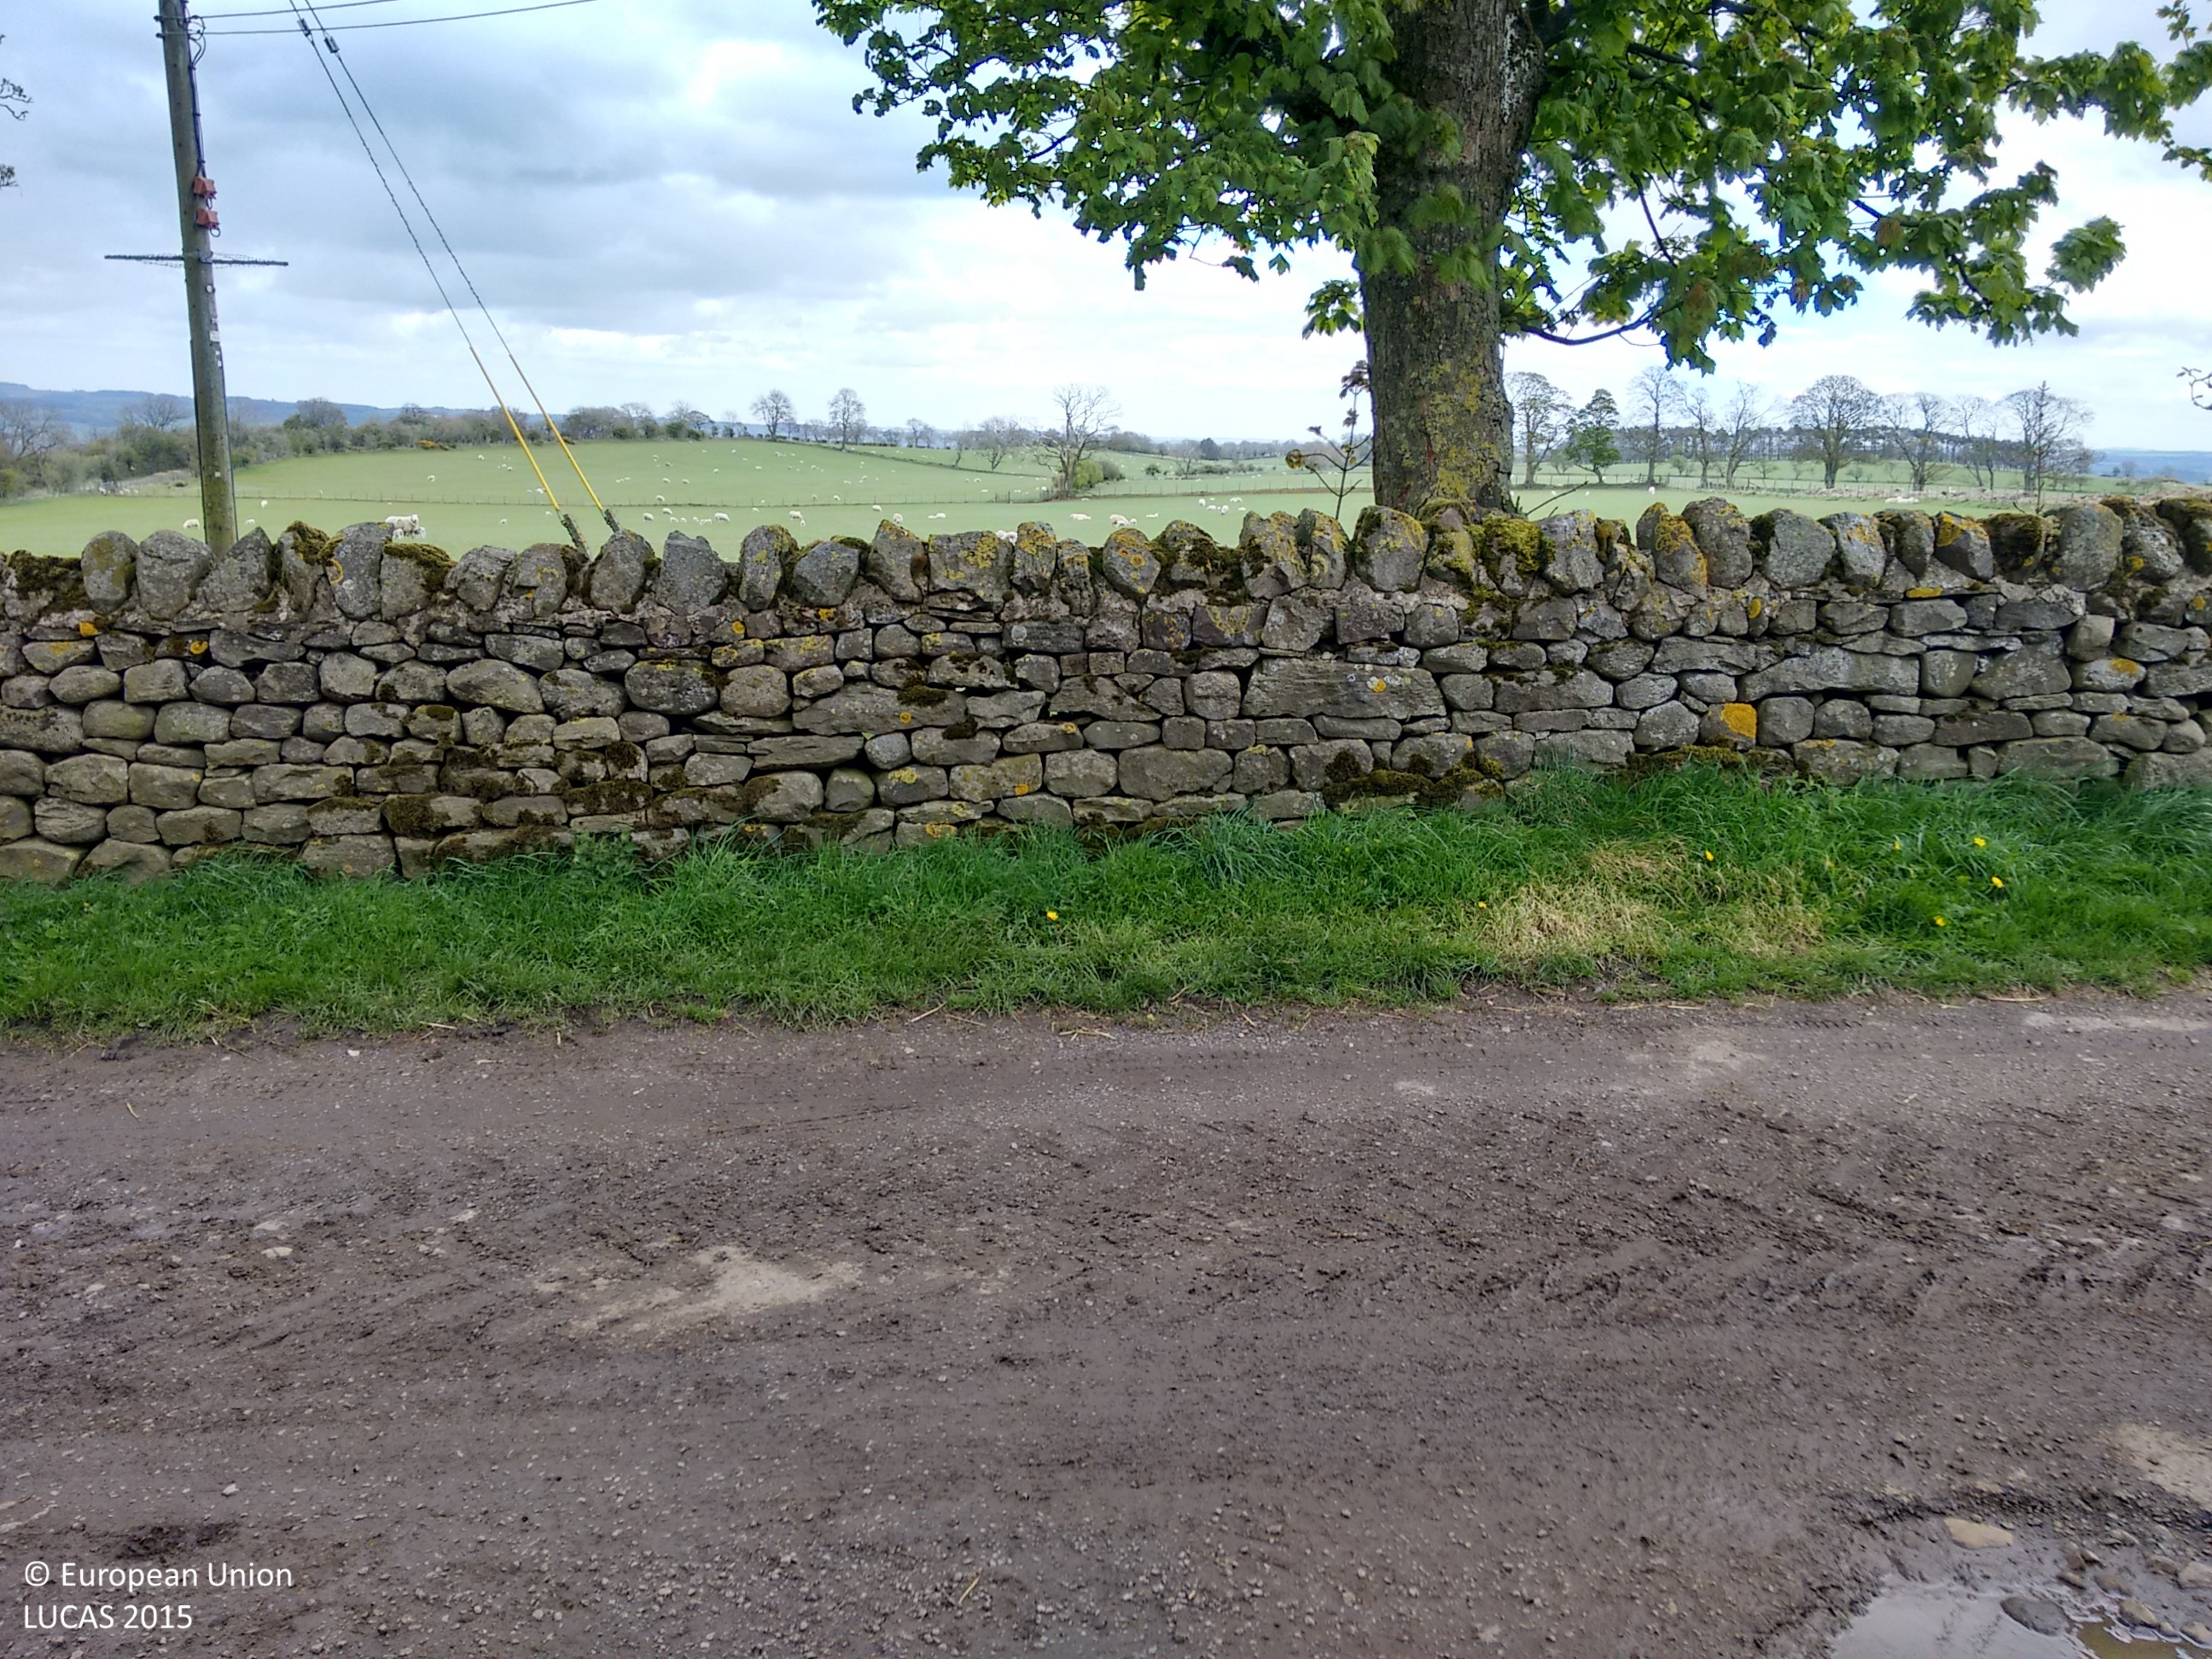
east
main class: Grassland
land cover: Grassland without tree/shrub cover
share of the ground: > 75 %
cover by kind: herbaceous plants 100 %
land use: Agriculture (excluding fallow land and kitchen gardens)
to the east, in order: Grassland without tree/shrub cover; Fences; Managed hedges; Grassland without tree/shrub cover
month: May
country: GB
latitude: 54.9517
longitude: -2.1582
